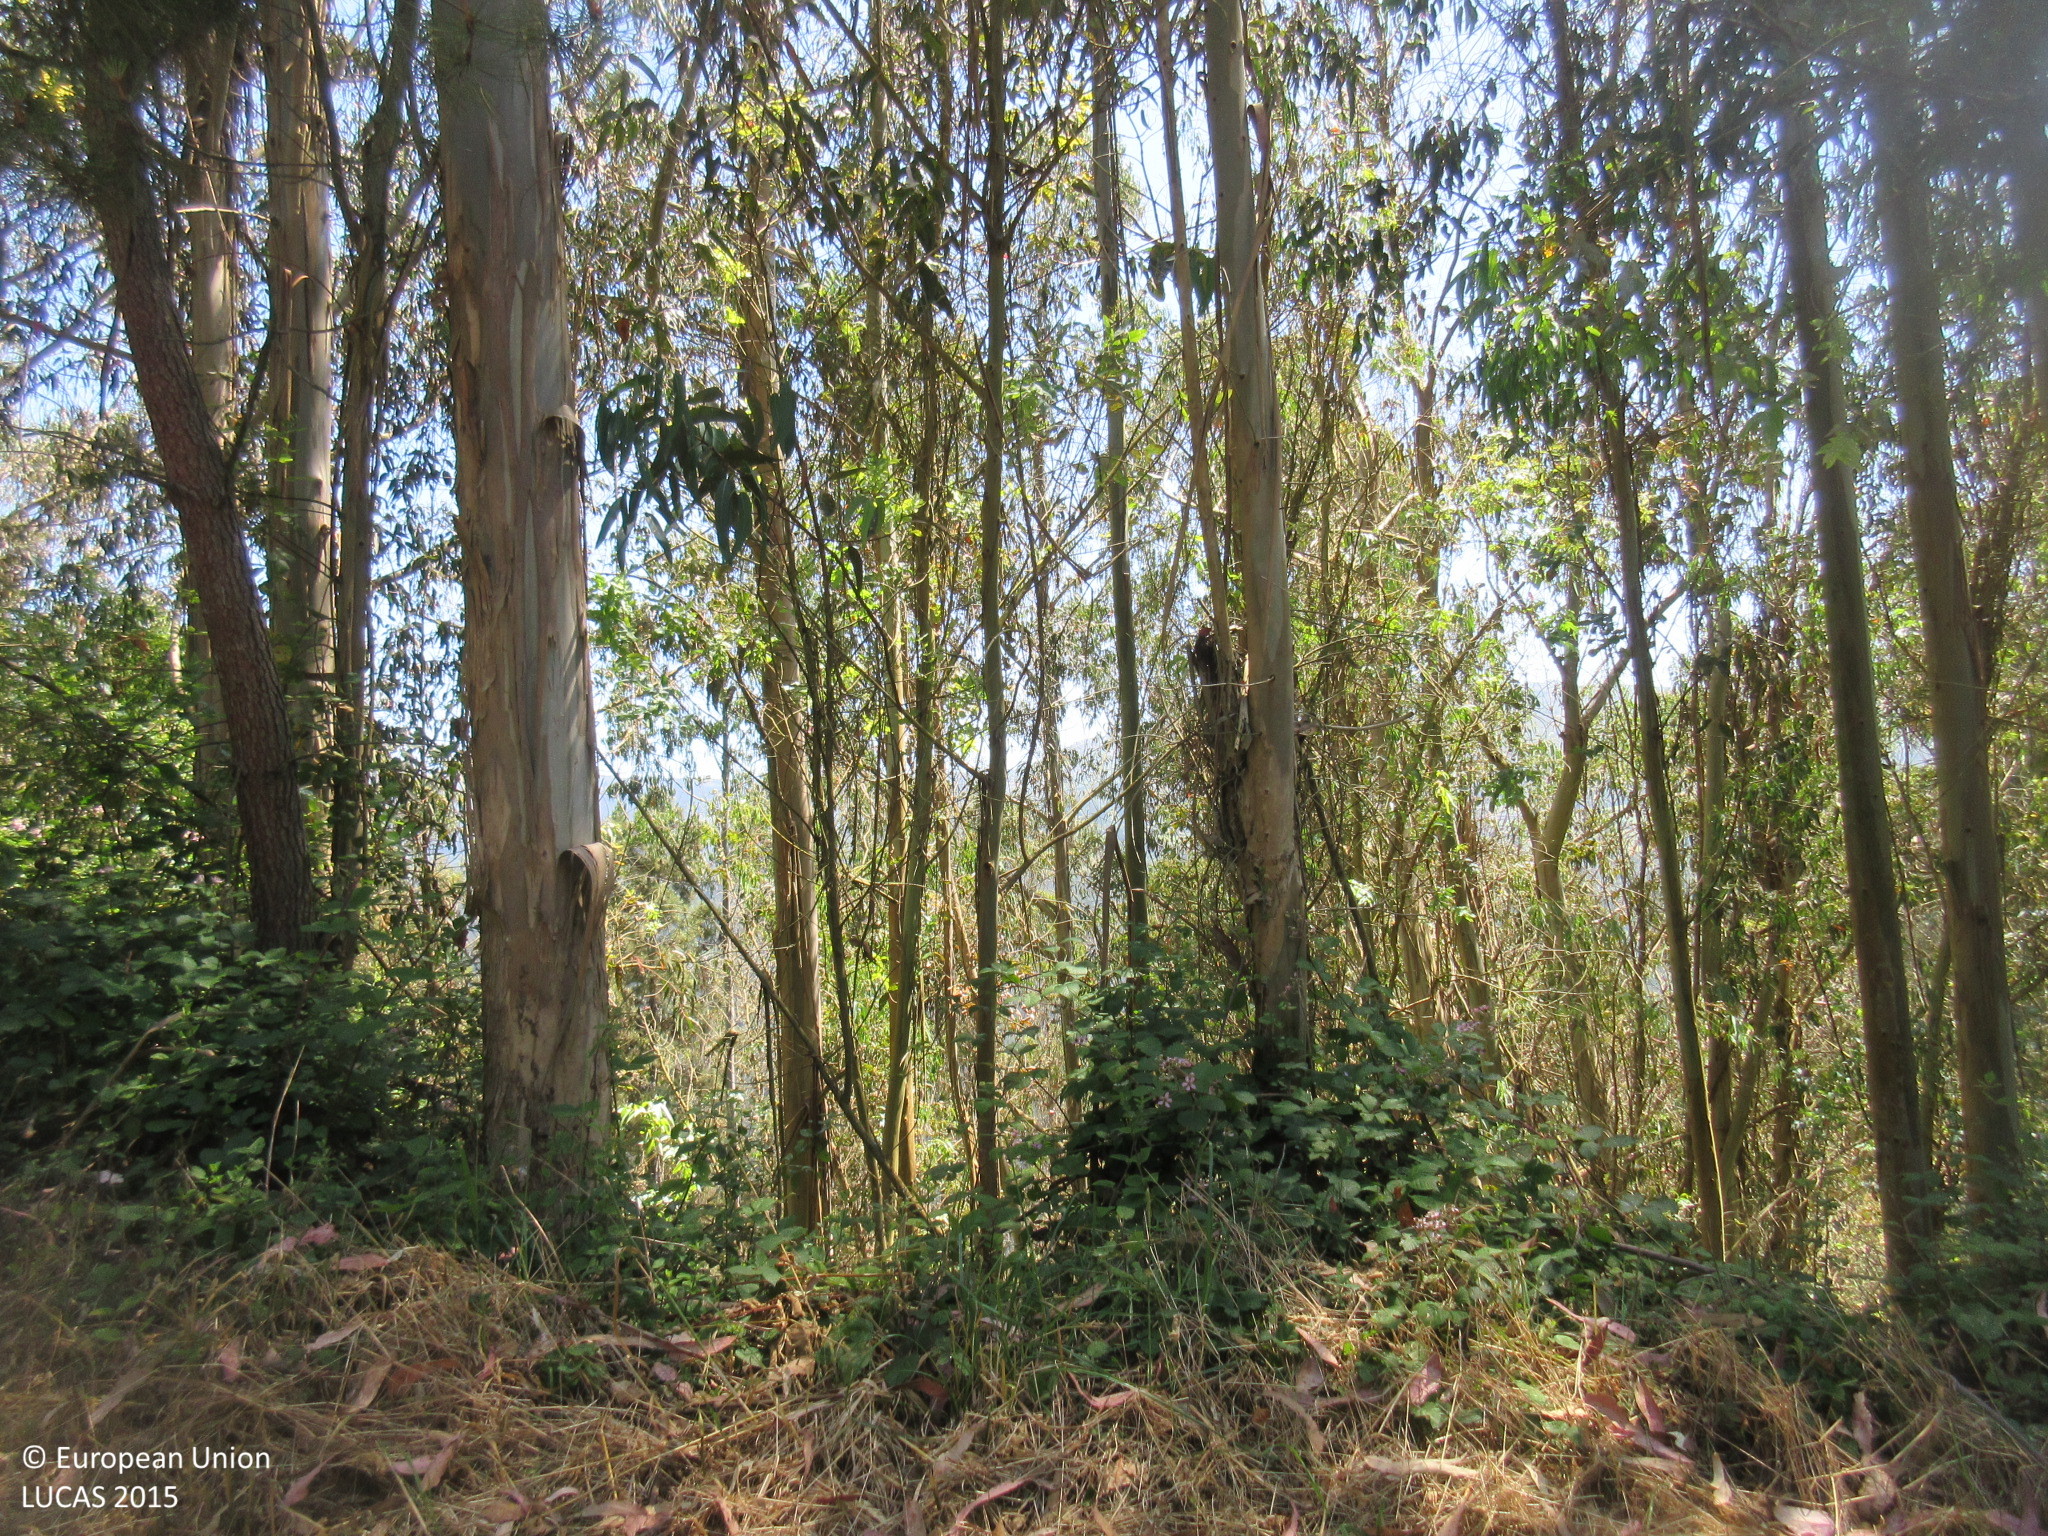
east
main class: Woodland
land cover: Broadleaved woodland
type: exotic forest
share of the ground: > 75 %
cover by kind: broadleaved forest trees 95 %, shrubs 5 %
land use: Forestry
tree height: > 5 m
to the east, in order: Broadleaved woodland; Shrubland without tree cover; Shrubland with sparse tree cover; Grass margins; Paved roads, cycling and walking lanes; Grass margins; Broadleaved woodland; Shrubland without tree cover
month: June
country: ES
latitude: 43.2113
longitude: -7.2168
